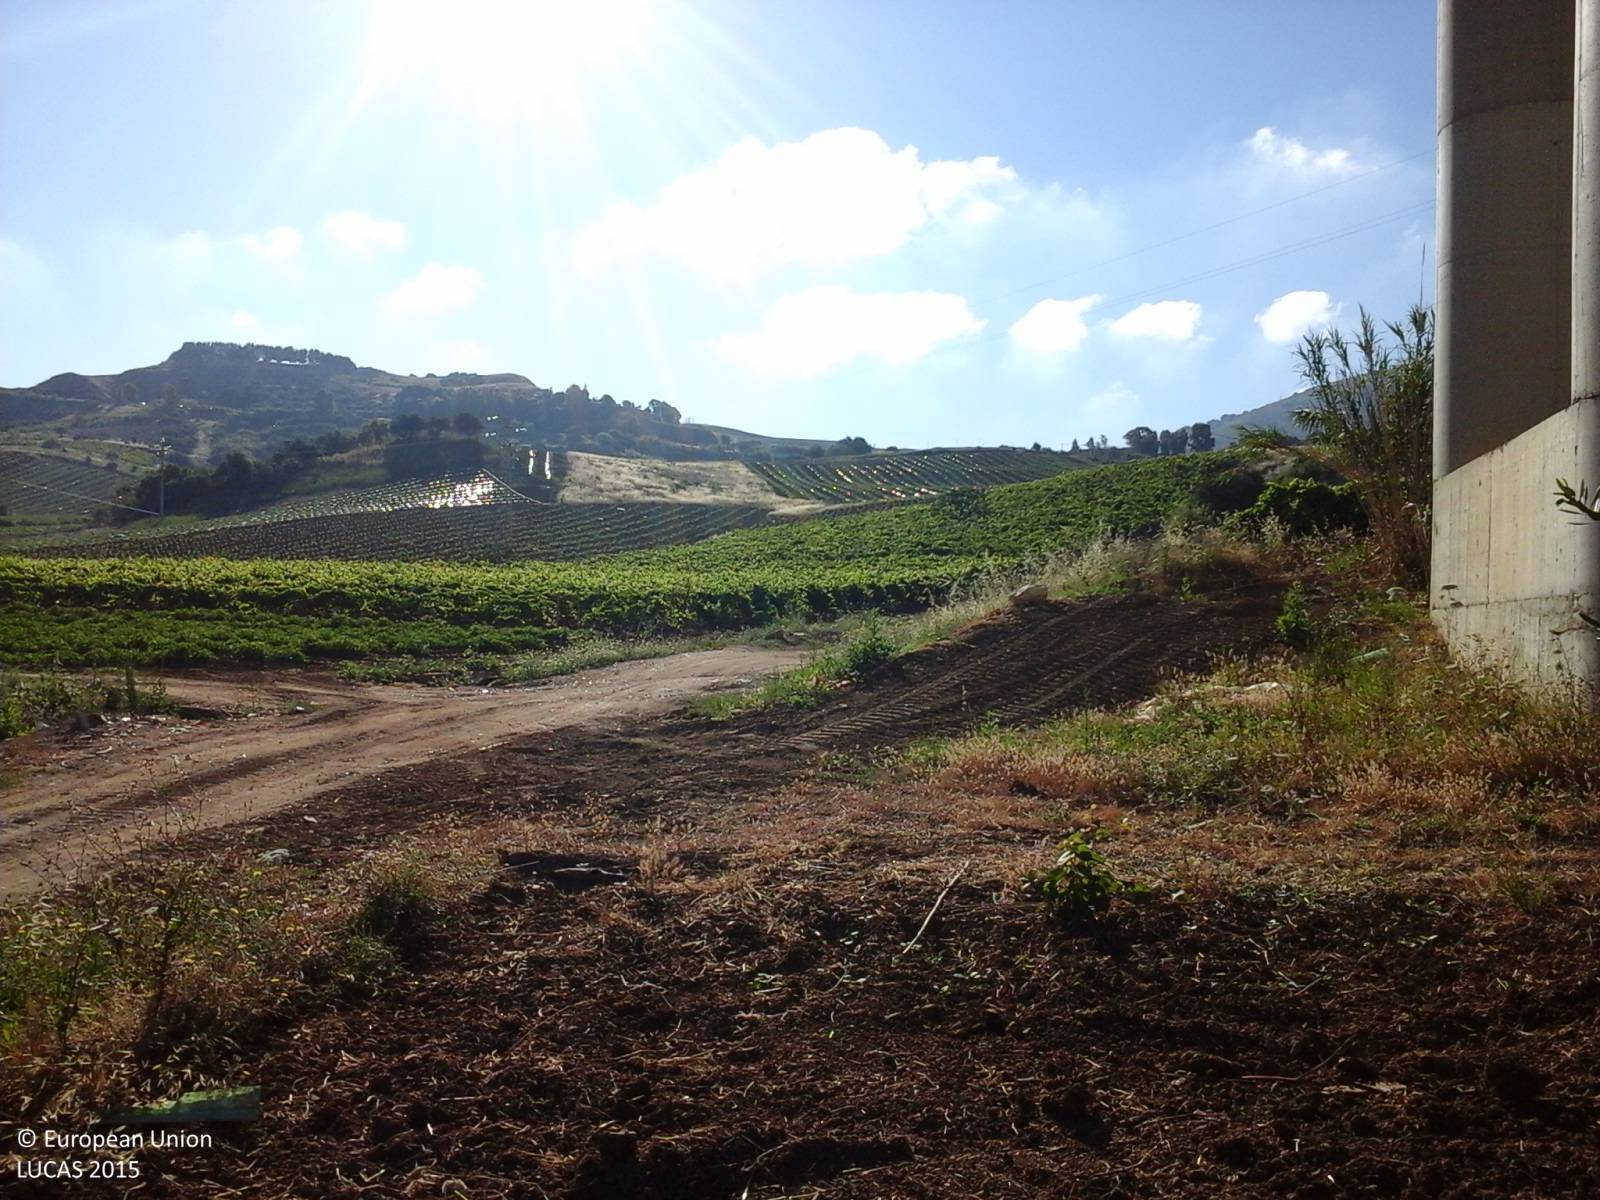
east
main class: Cropland
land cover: Olive groves
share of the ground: 25 - 50 %
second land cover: Other bare soil
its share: > 75 %
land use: Agriculture (excluding fallow land and kitchen gardens)
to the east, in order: Olive groves; Other bare soil; Tracks; Grass margins; Ditches and canals; Vineyards
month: June
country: IT
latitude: 37.9749
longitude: 12.9273
